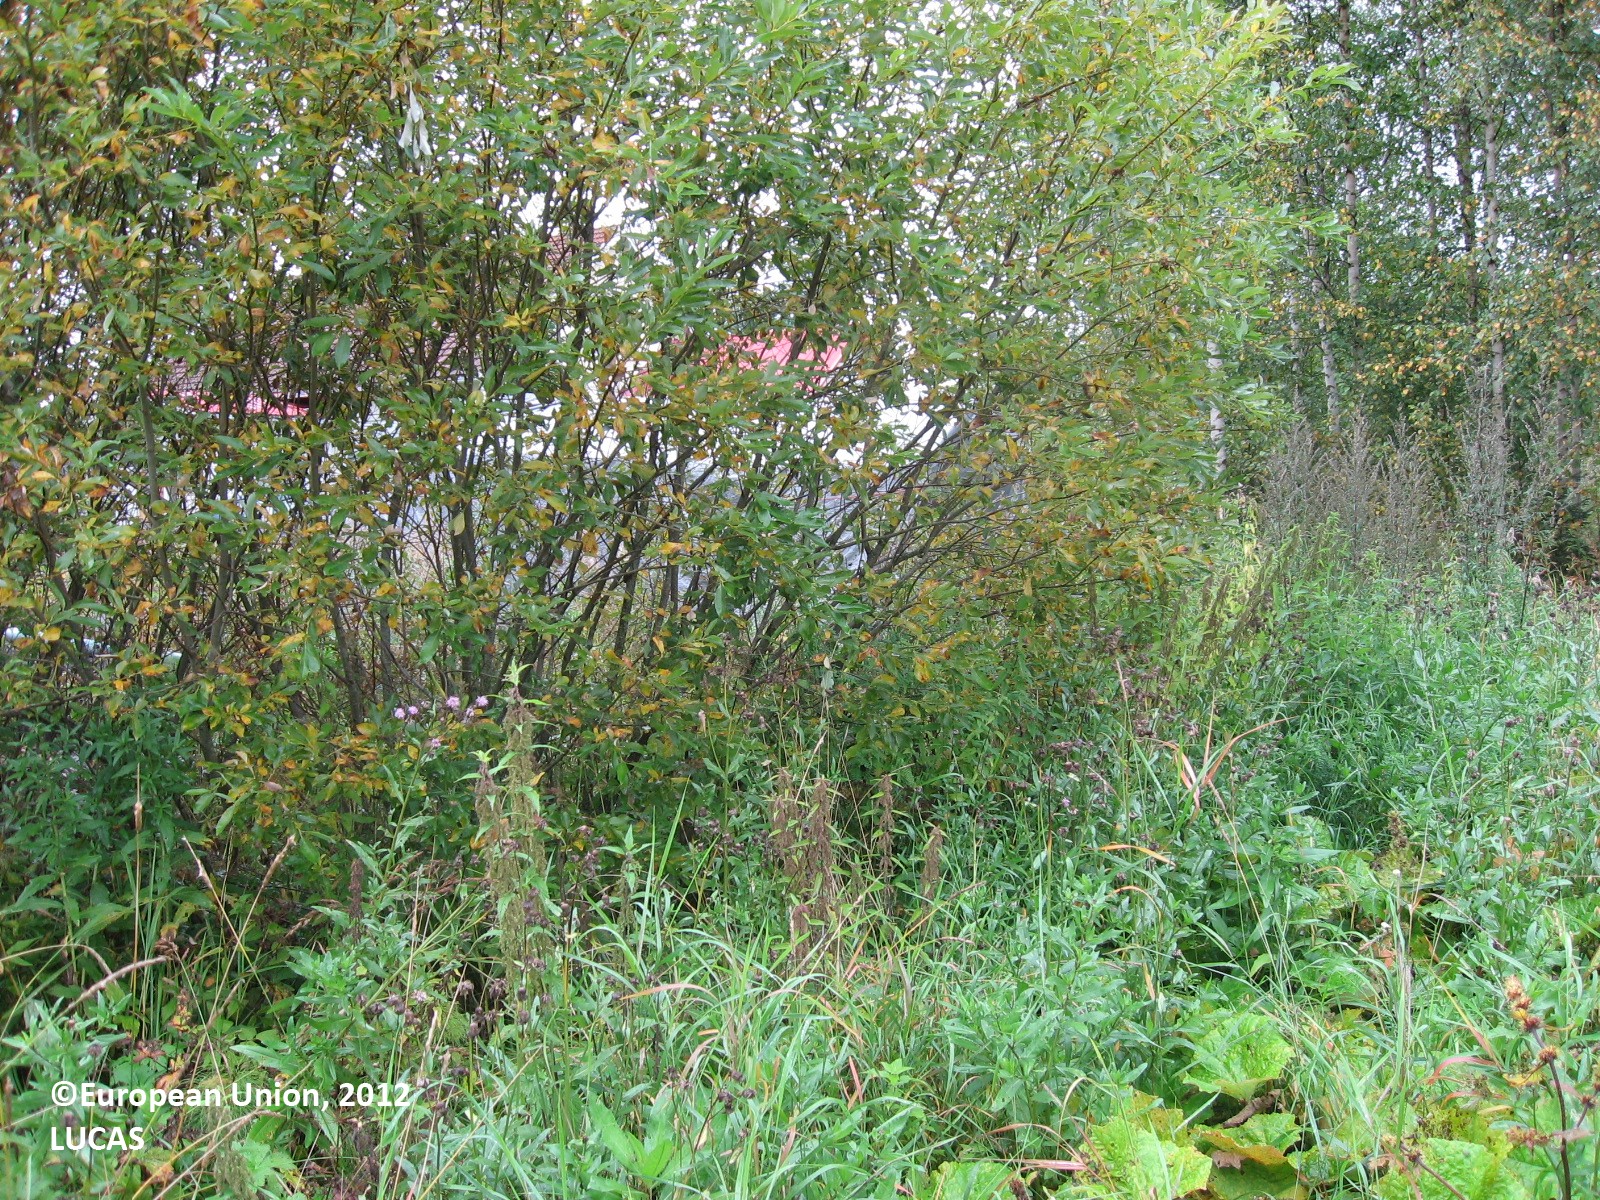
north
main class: Cropland
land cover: Oats
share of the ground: > 75 %
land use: Agriculture (excluding fallow land and kitchen gardens)
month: August
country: FI
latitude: 61.4351
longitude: 24.7846
